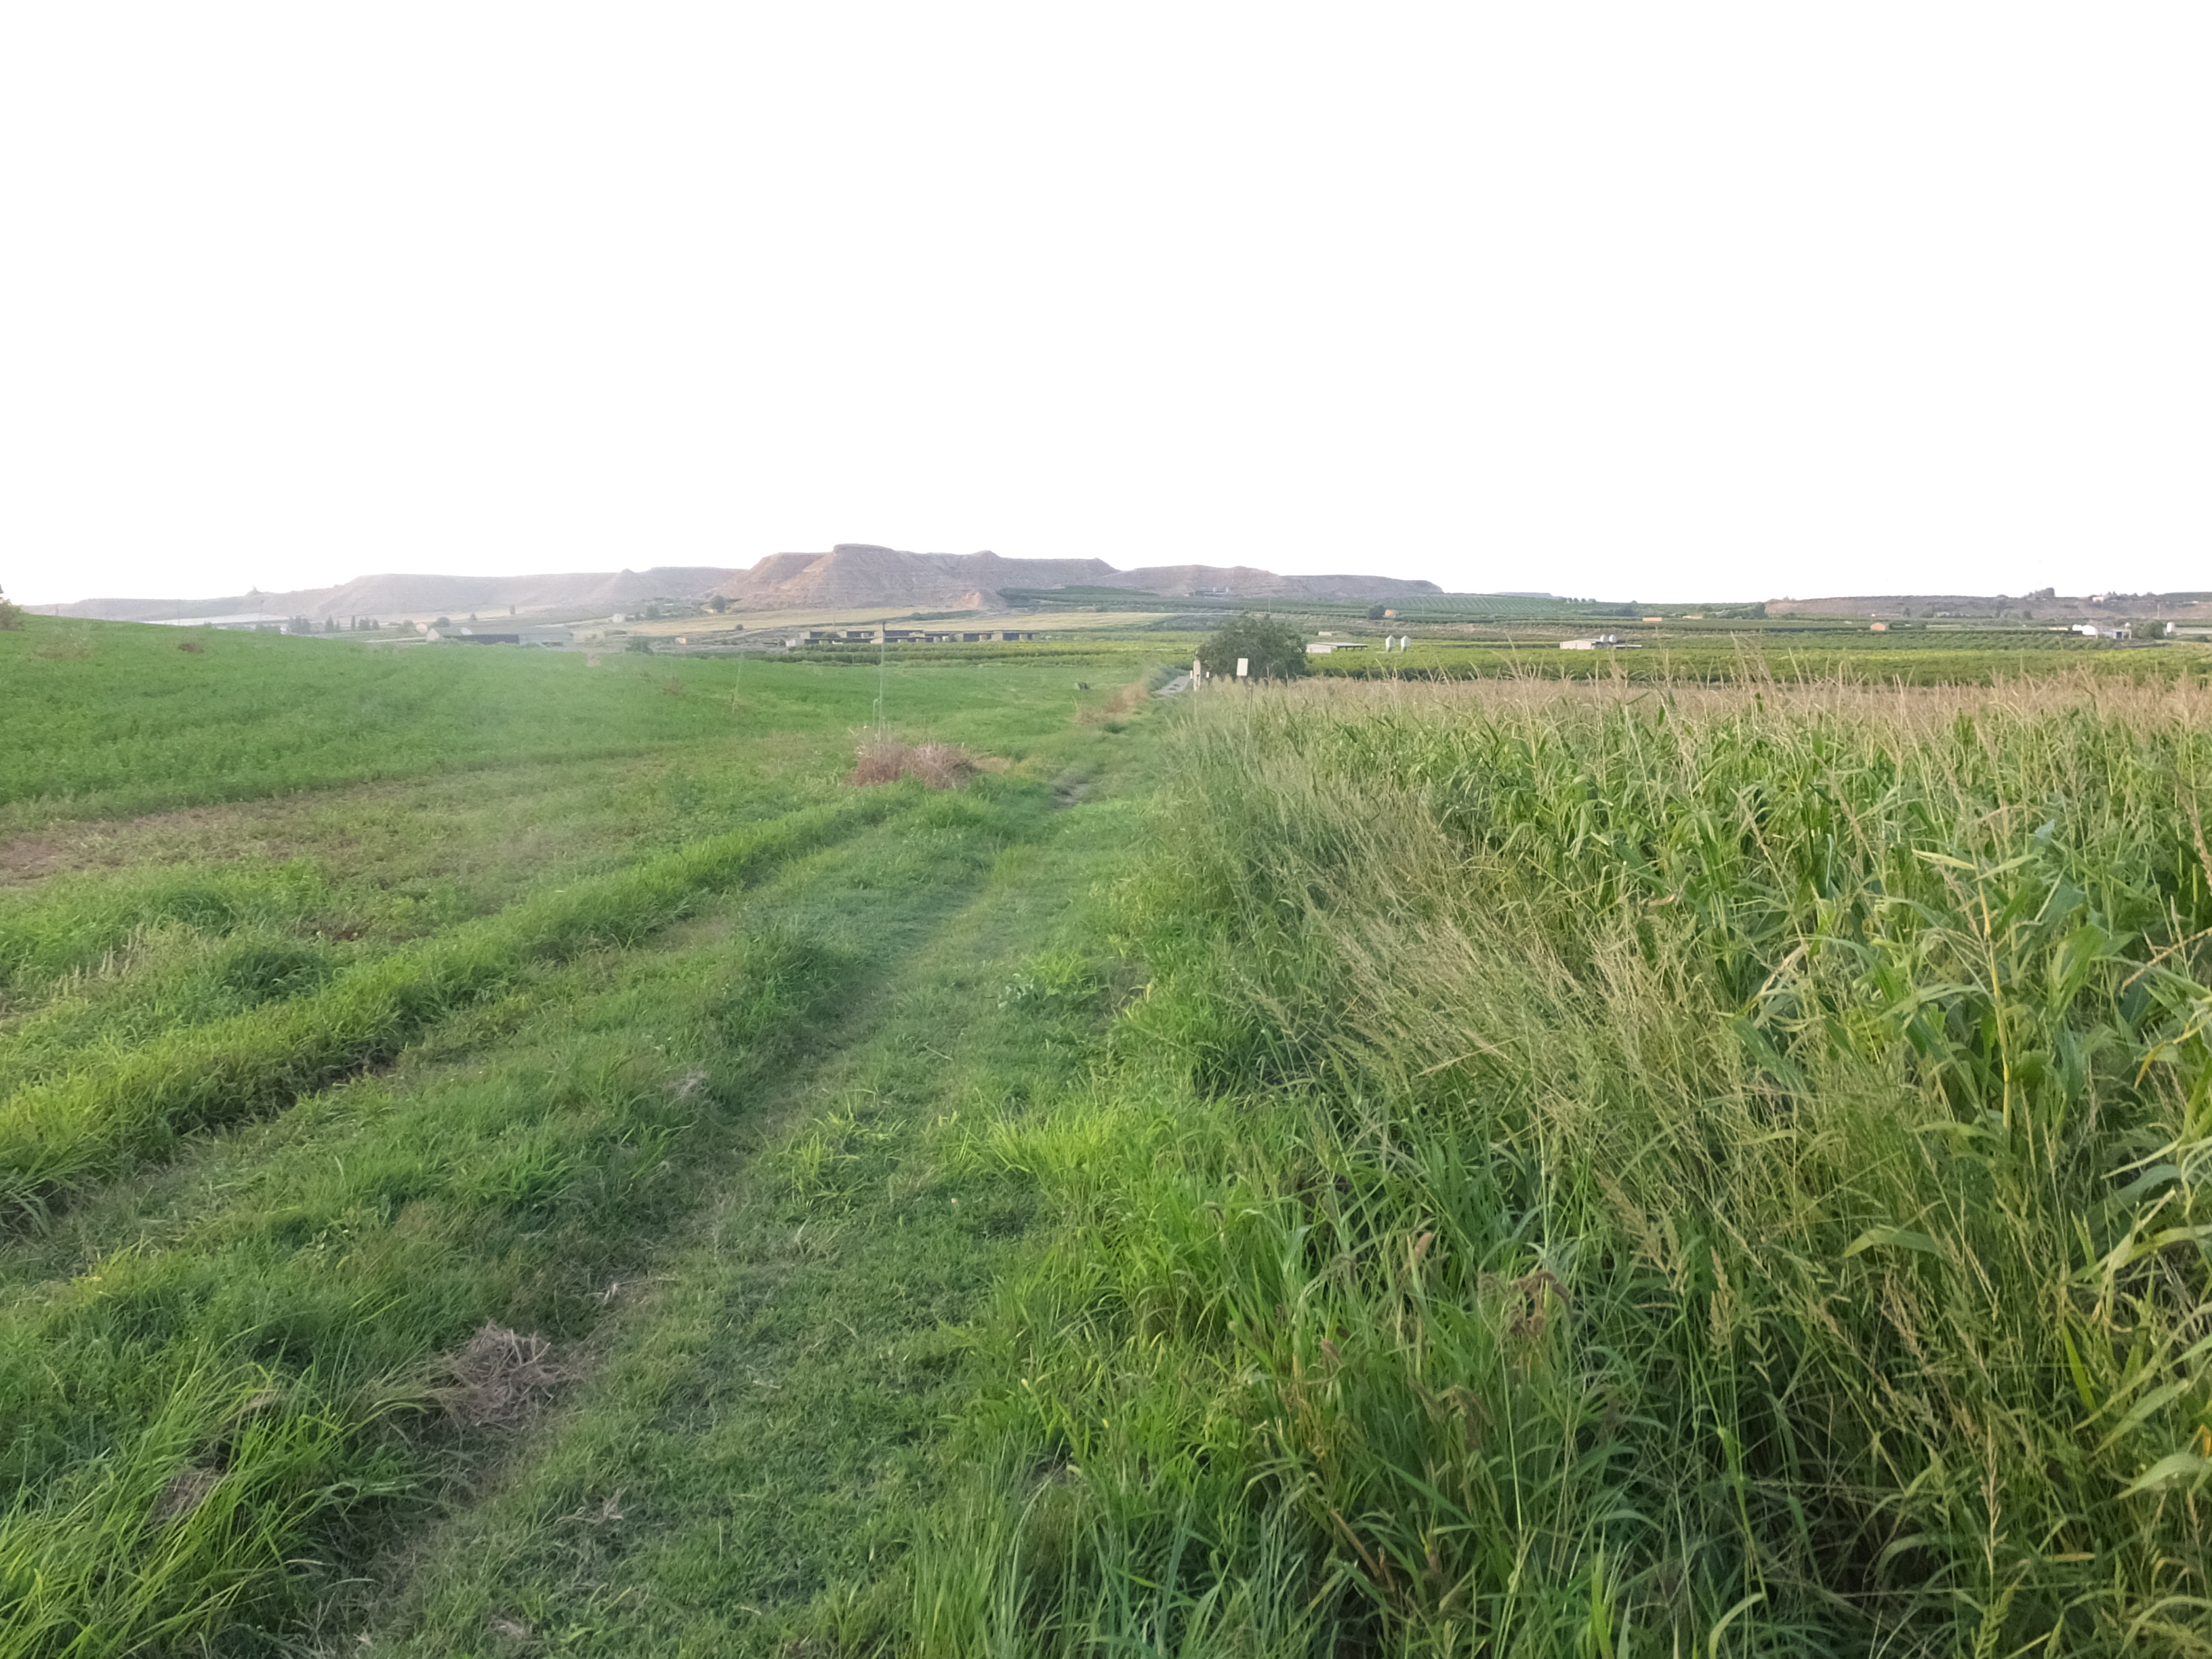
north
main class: Cropland
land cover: Maize
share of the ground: > 75 %
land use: Agriculture (excluding fallow land and kitchen gardens)
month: August
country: ES
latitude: 41.5839
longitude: 0.4511
